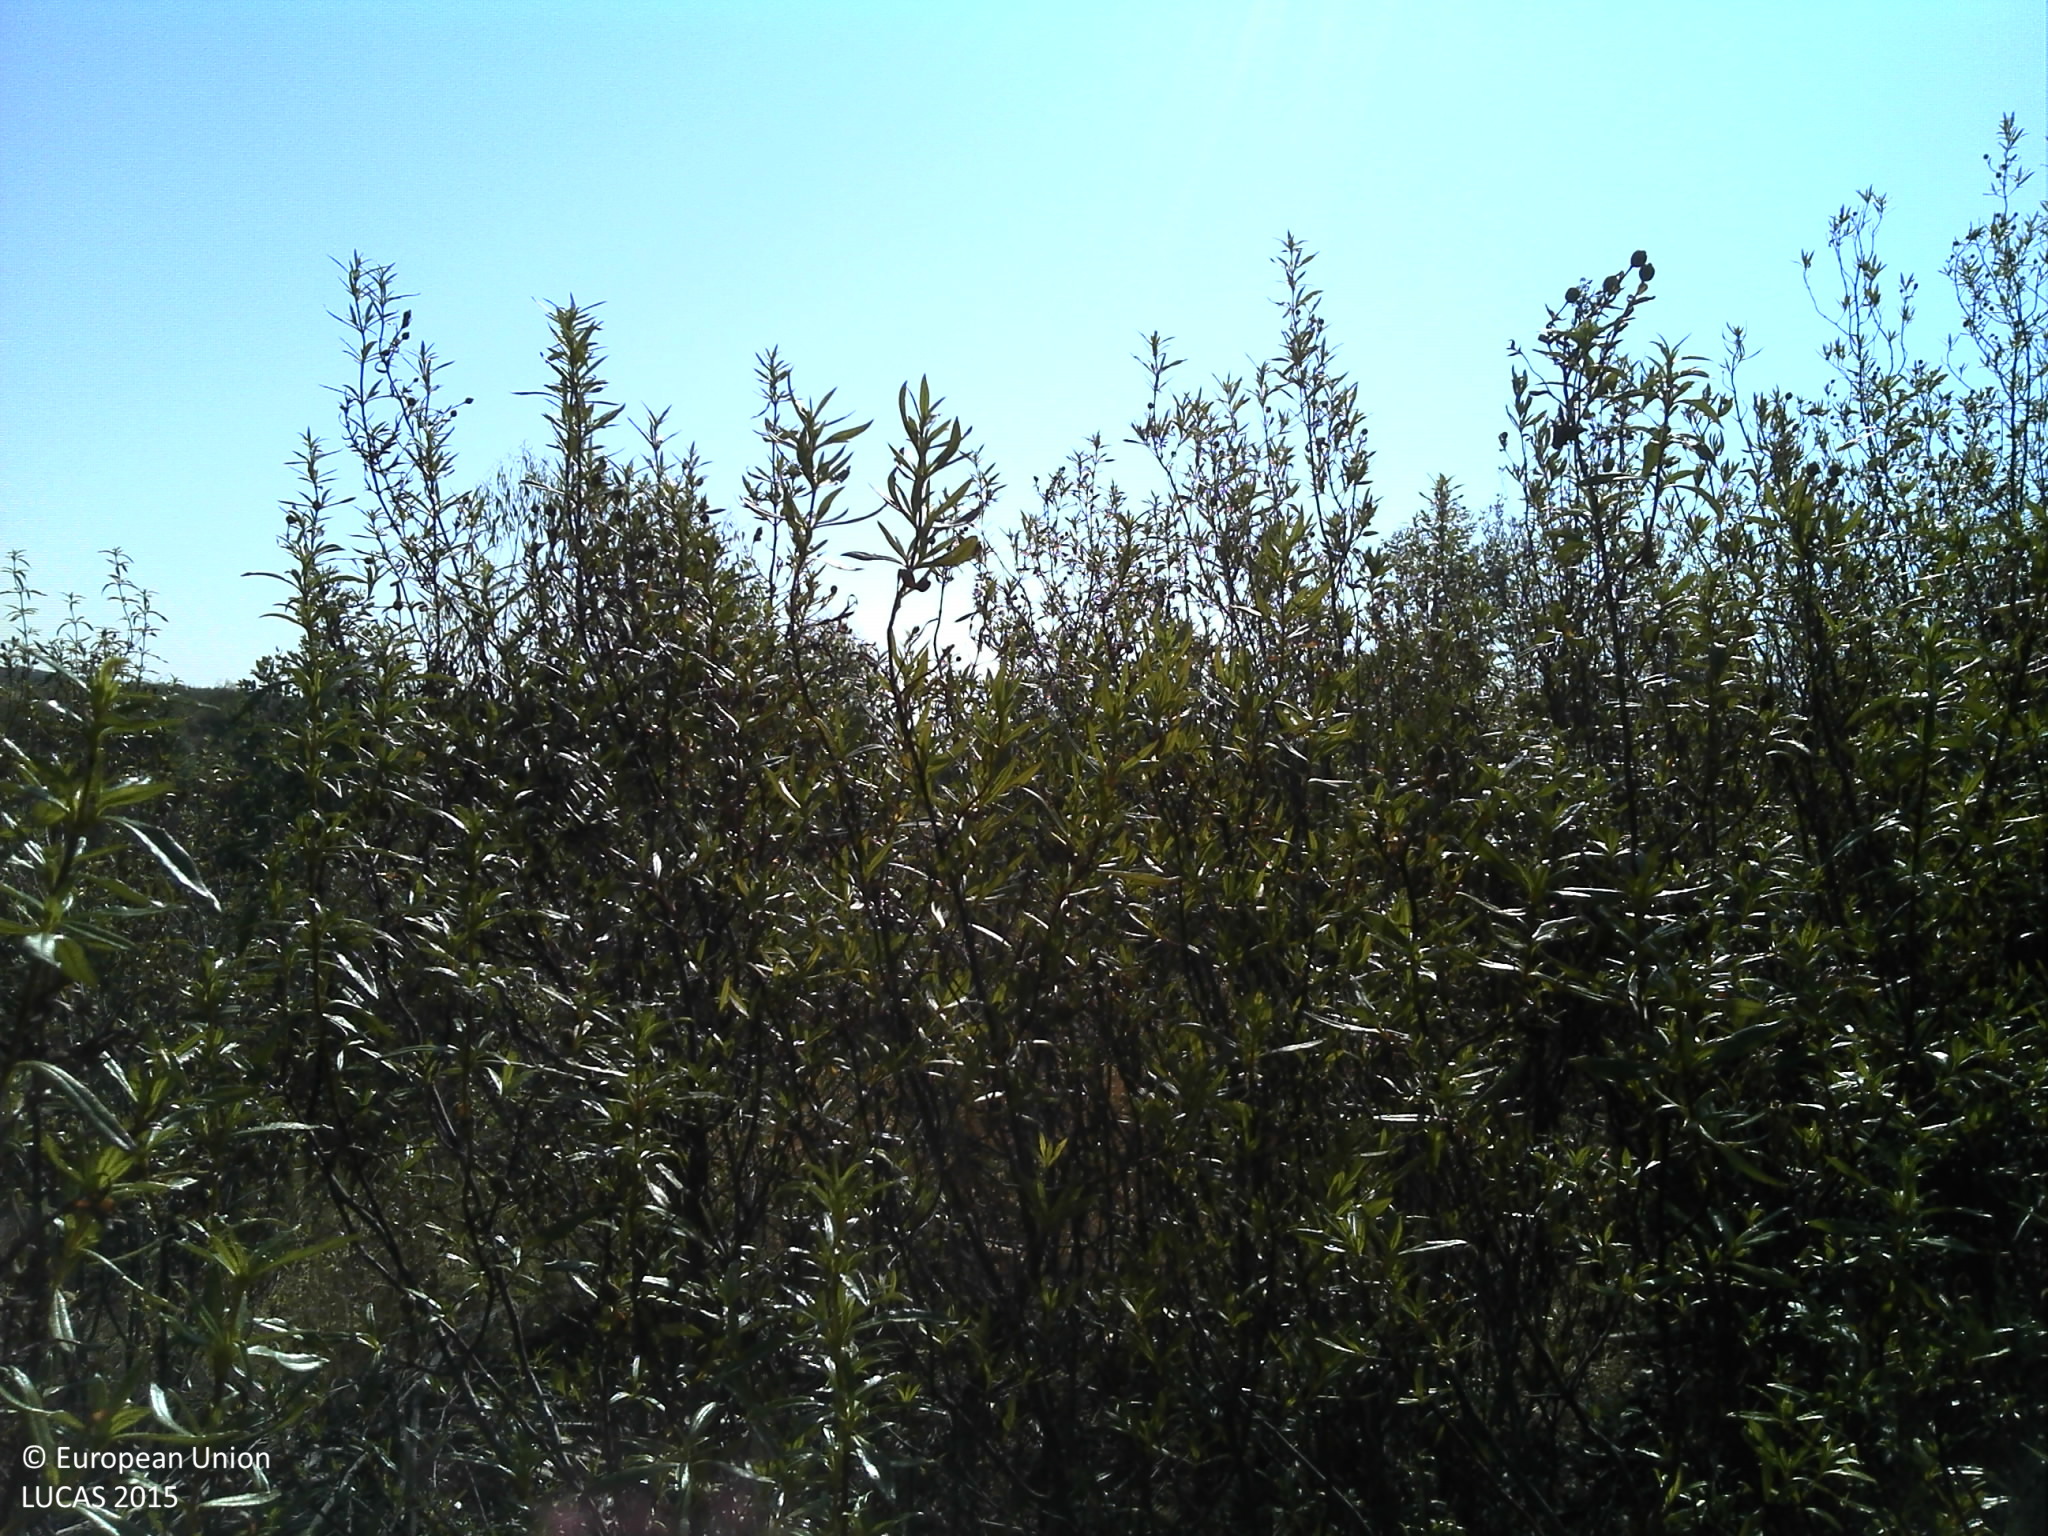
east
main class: Woodland
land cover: Broadleaved woodland
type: exotic forest
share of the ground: 25 - 50 %
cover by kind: shrubs 40 %, broadleaved forest trees 25 %, herbaceous plants 15 %, consolidated bare surface 10 %, unconsolidated bare surface 10 %
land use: Forestry
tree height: < 5 m
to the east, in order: Broadleaved woodland; Tracks; Broadleaved woodland; Tracks; Broadleaved woodland; Tracks; Broadleaved woodland
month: July
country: PT
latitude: 38.5979
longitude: -7.4473
